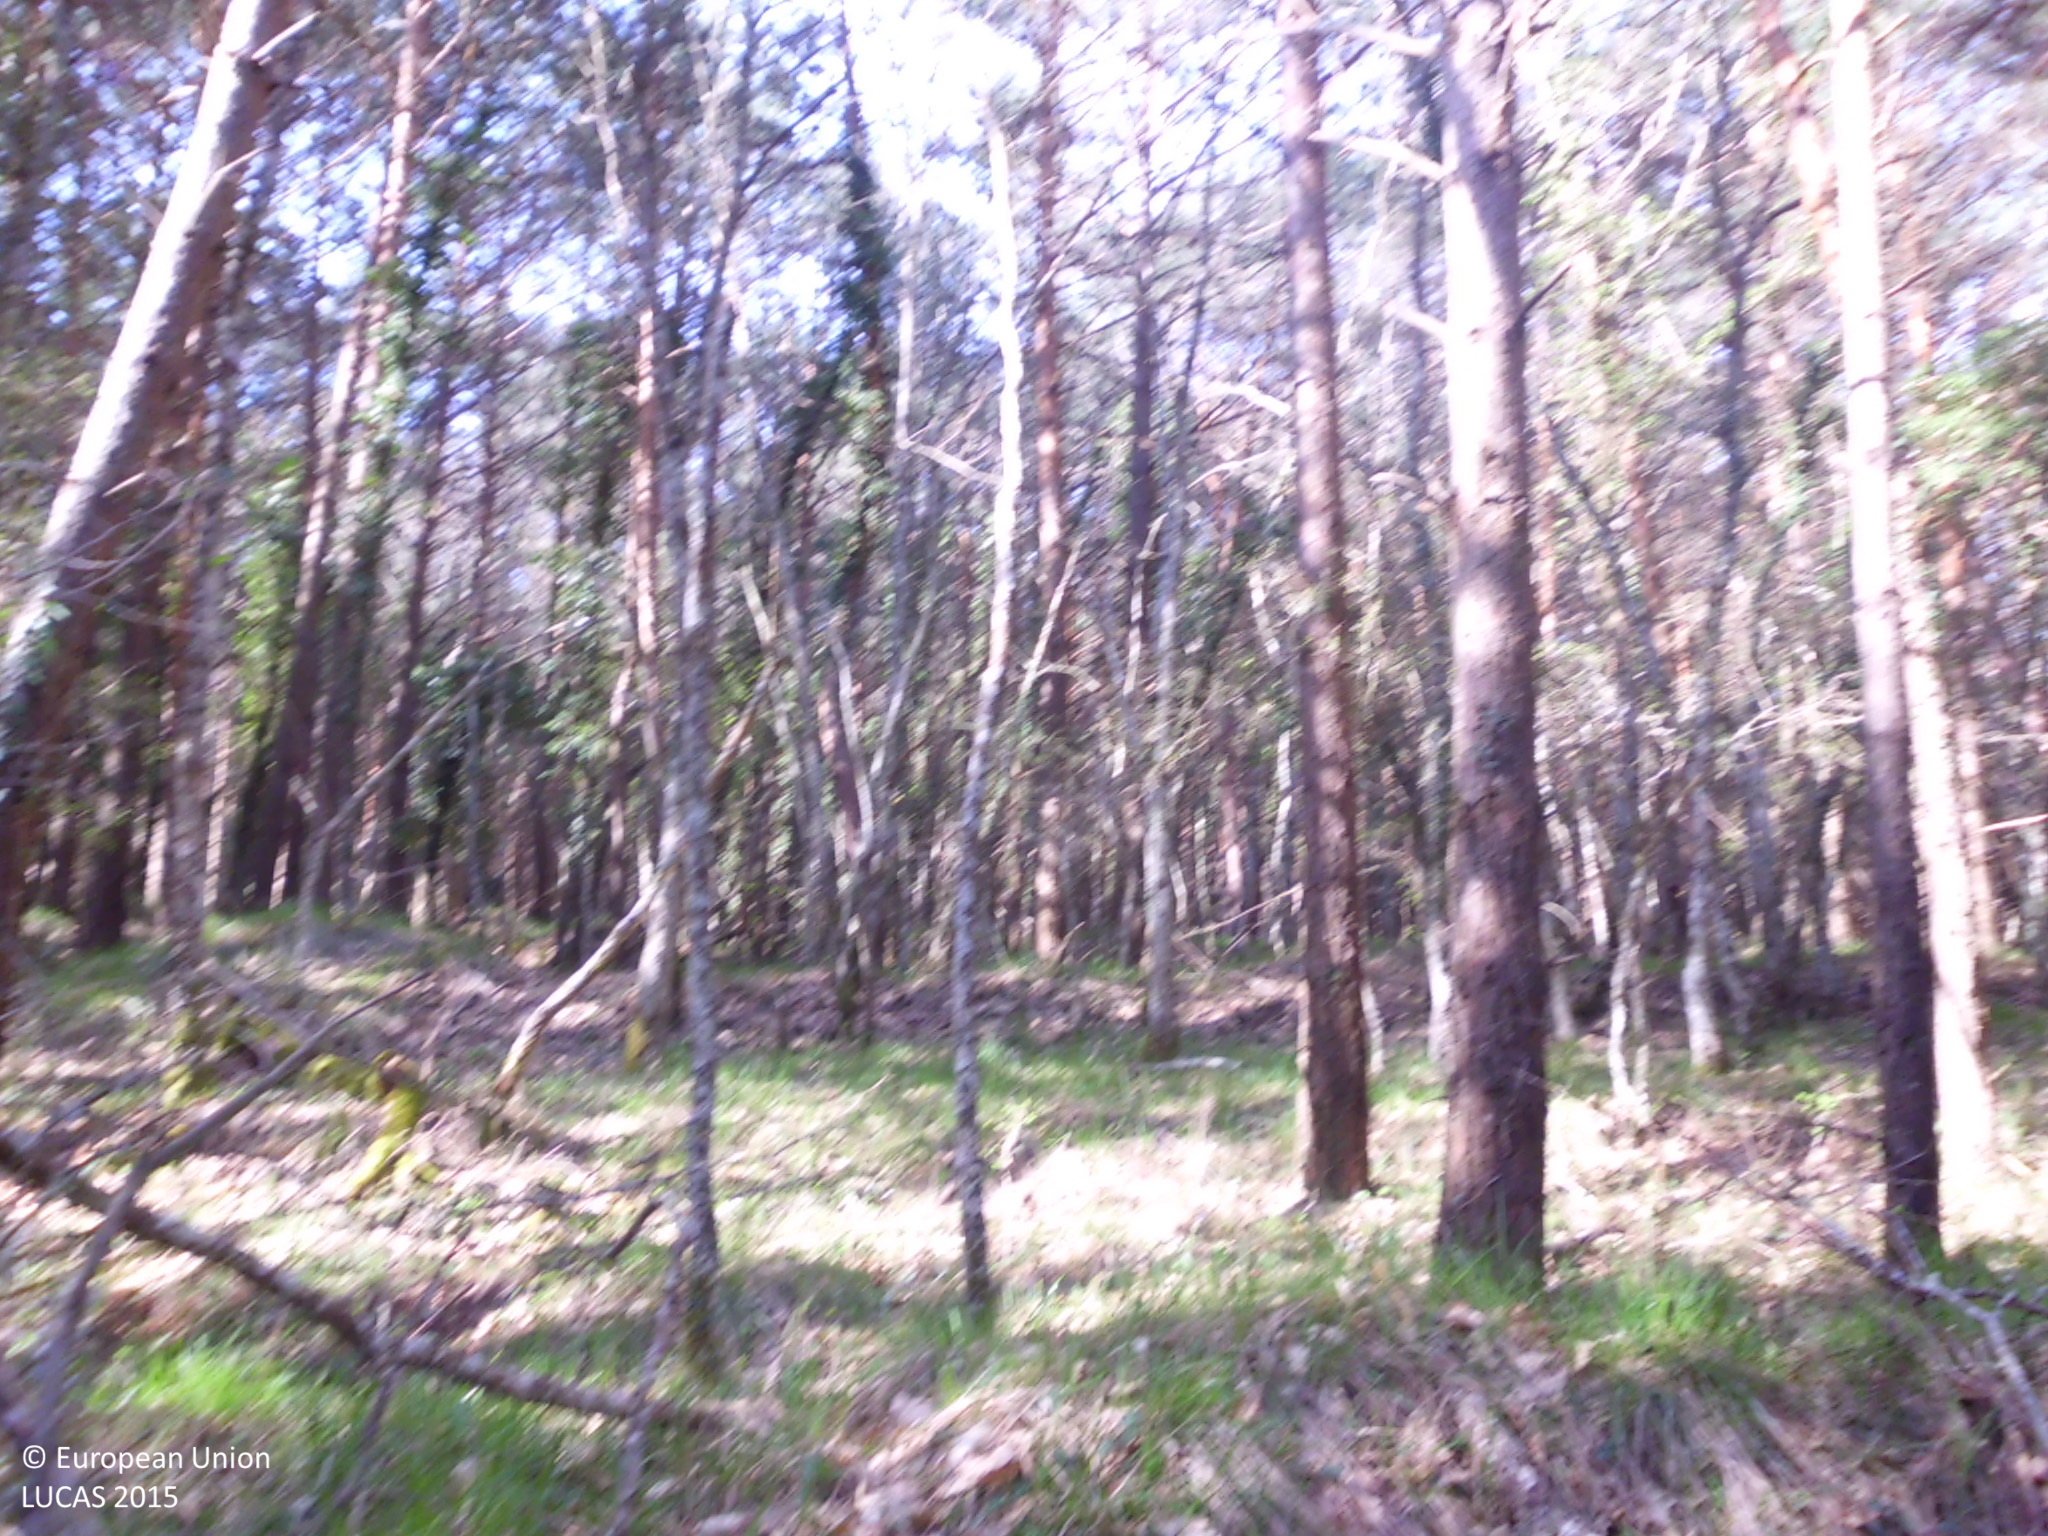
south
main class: Woodland
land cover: Pine dominated coniferous woodland
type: coniferous forest of the mediterranean region
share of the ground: > 75 %
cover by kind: coniferous forest trees 100 %
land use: Forestry
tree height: > 5 m
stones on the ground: < 10 %
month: April
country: ES
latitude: 42.3801
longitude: -3.4043
